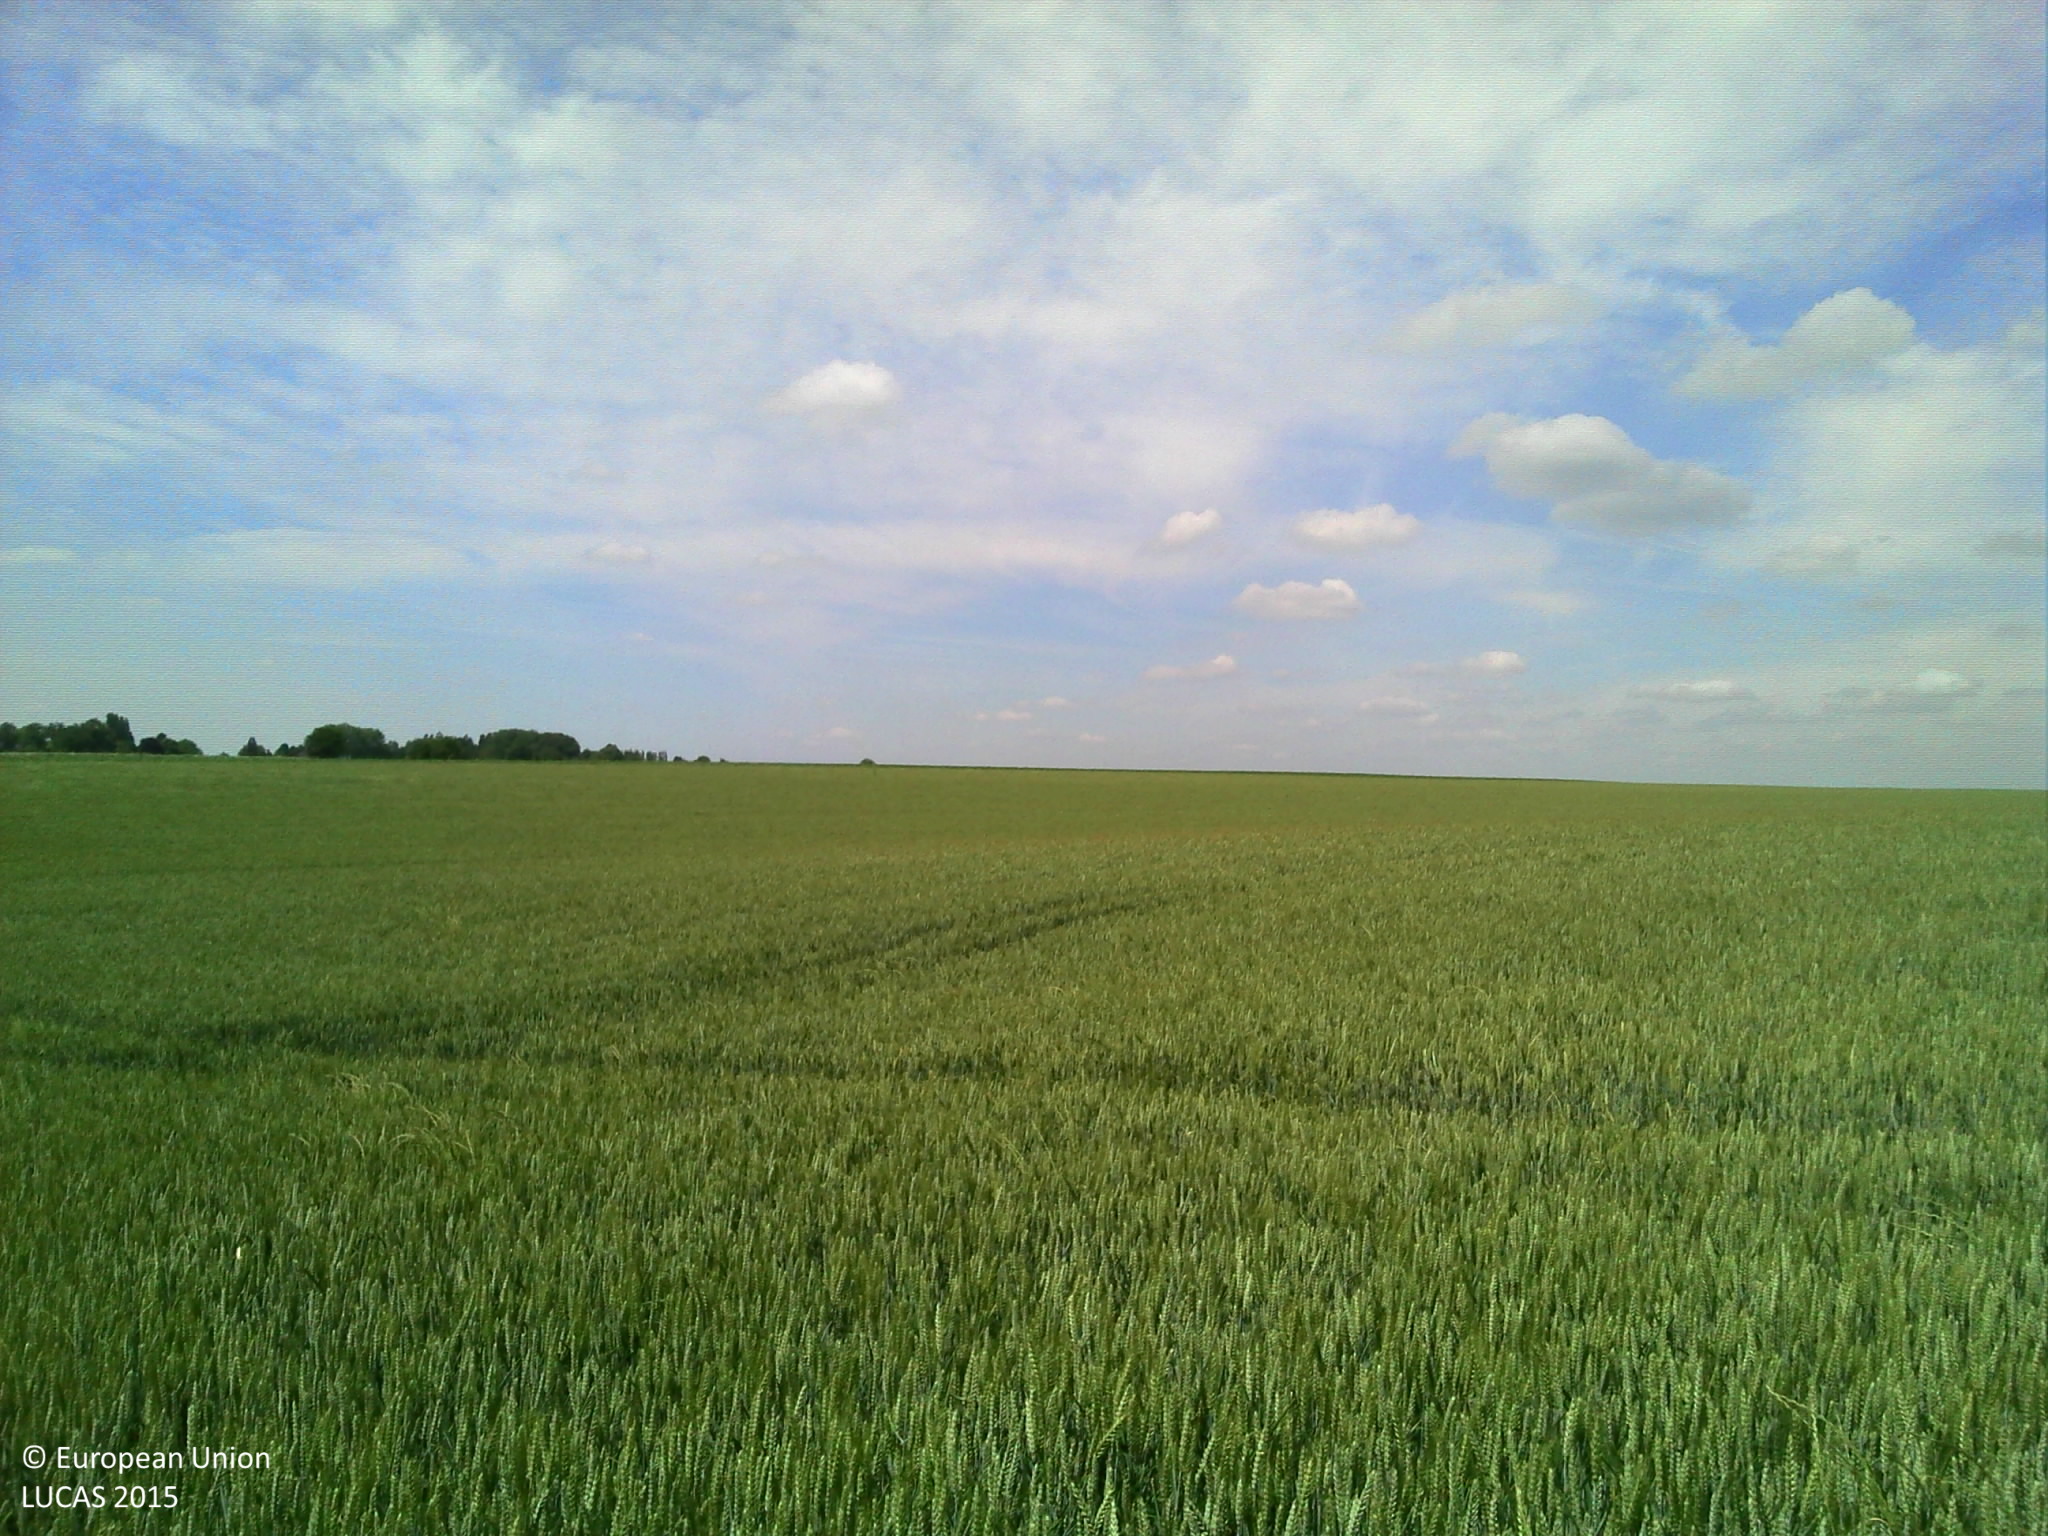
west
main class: Cropland
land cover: Common wheat
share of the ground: > 75 %
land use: Agriculture (excluding fallow land and kitchen gardens)
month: June
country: FR
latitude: 49.5959
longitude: 2.5309
